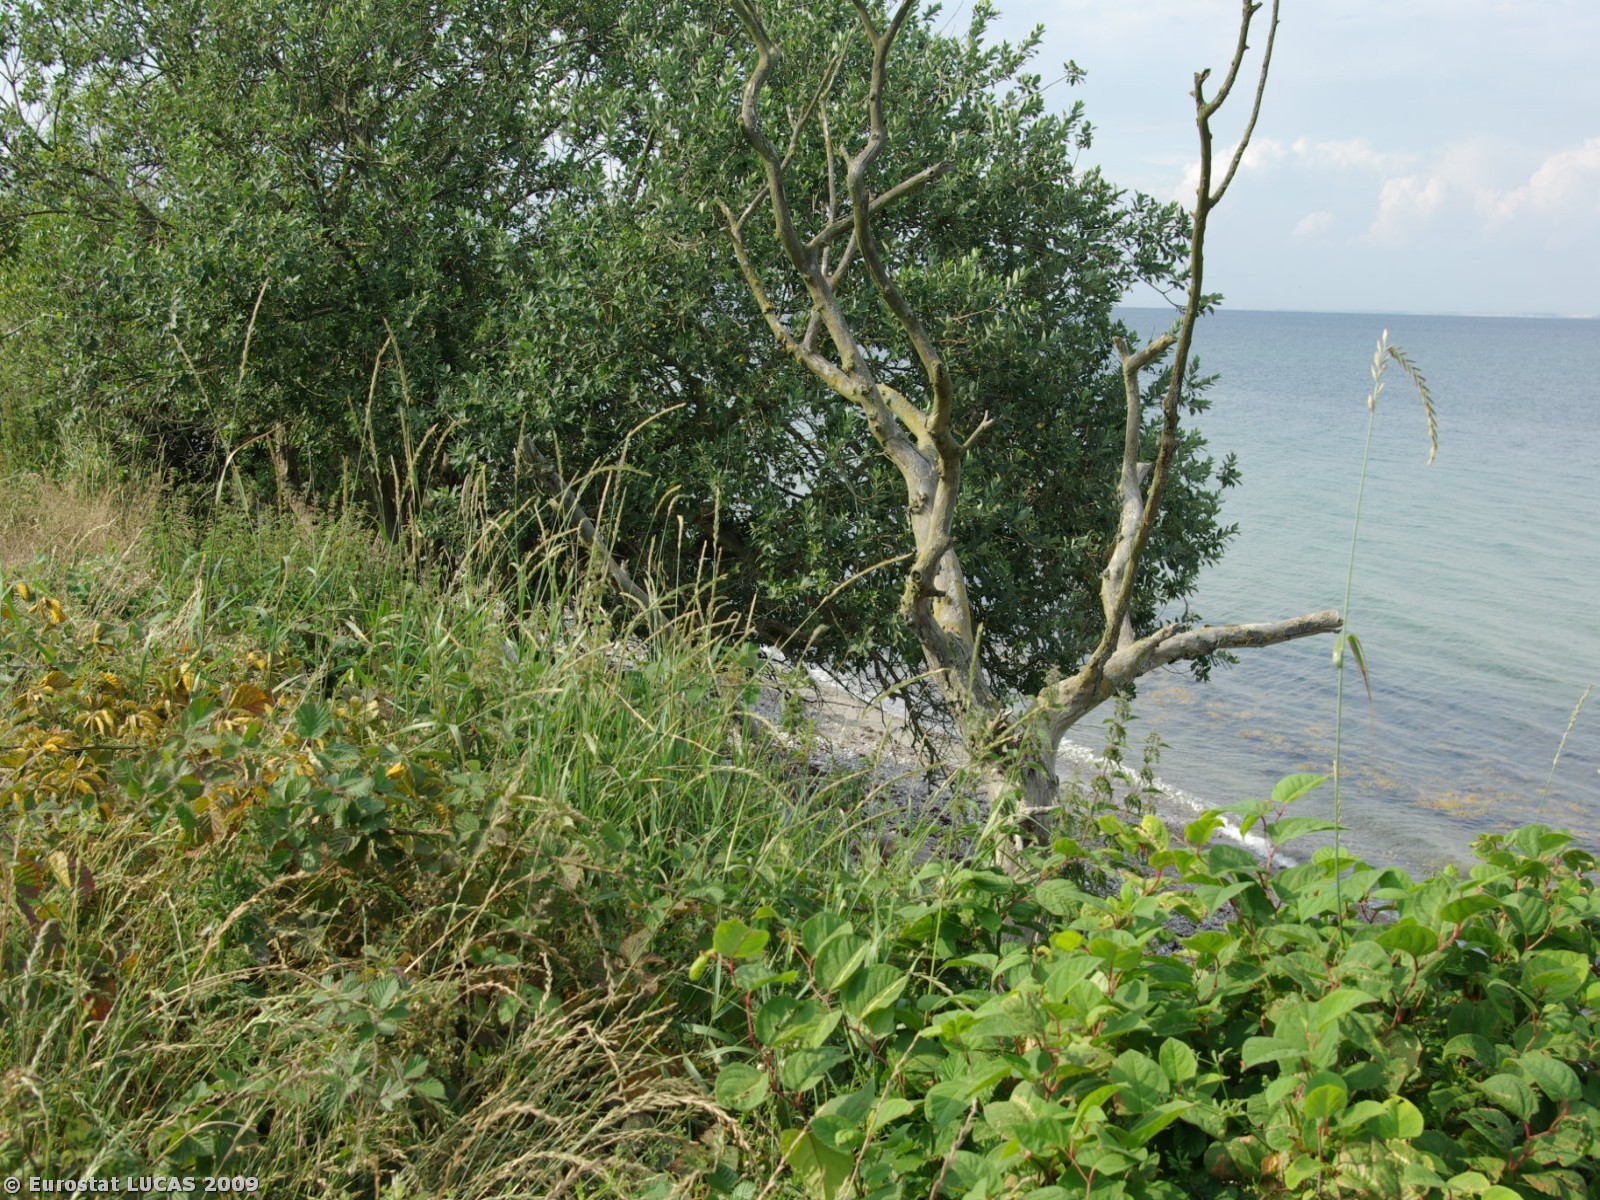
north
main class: Cropland
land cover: Common wheat
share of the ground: > 75 %
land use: Agriculture (excluding fallow land and kitchen gardens)
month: July
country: DK
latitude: 55.0373
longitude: 9.8593
